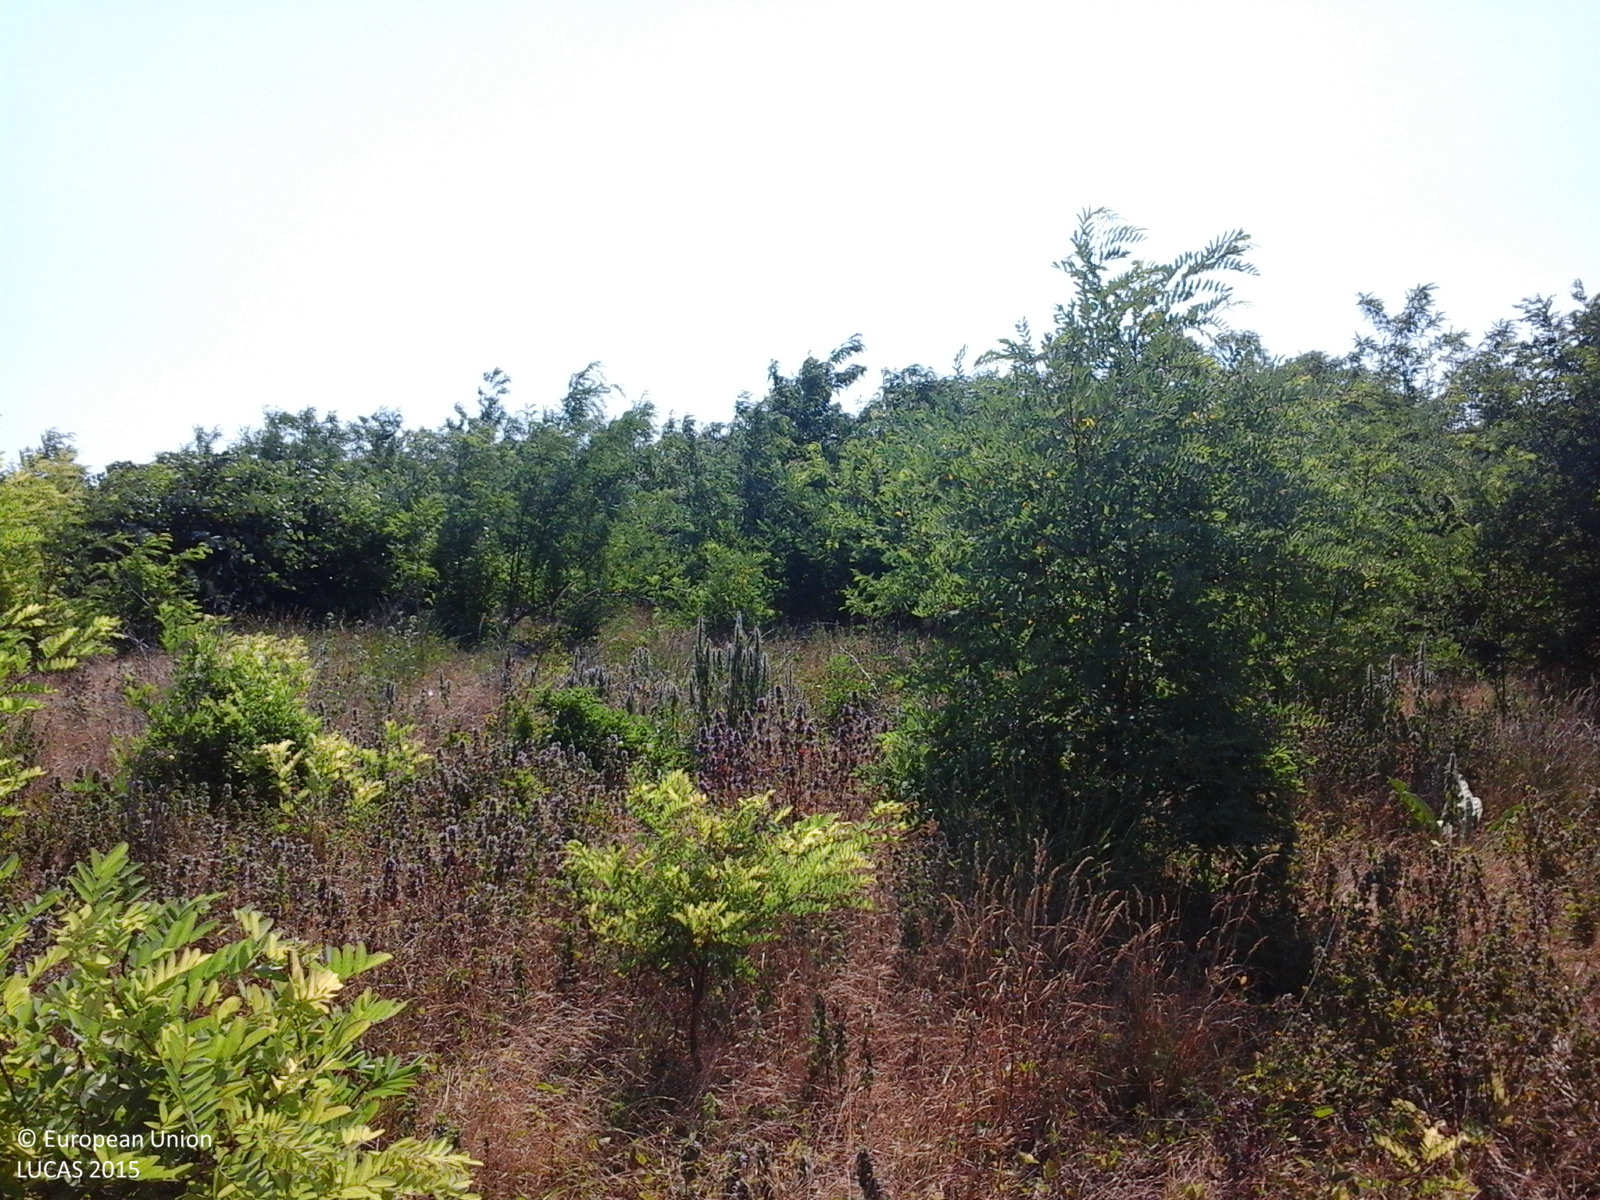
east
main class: Shrubland
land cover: Shrubland with sparse tree cover
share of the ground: > 75 %
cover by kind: shrubs 65 %, herbaceous plants 30 %, broadleaved forest trees 5 %
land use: Semi-natural and natural areas not in use
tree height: < 5 m
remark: Clear cut
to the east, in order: Shrubland with sparse tree cover; Broadleaved woodland; Tracks; Broadleaved woodland; Shrubland with sparse tree cover
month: June
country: RO
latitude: 46.9055
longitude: 28.0240
